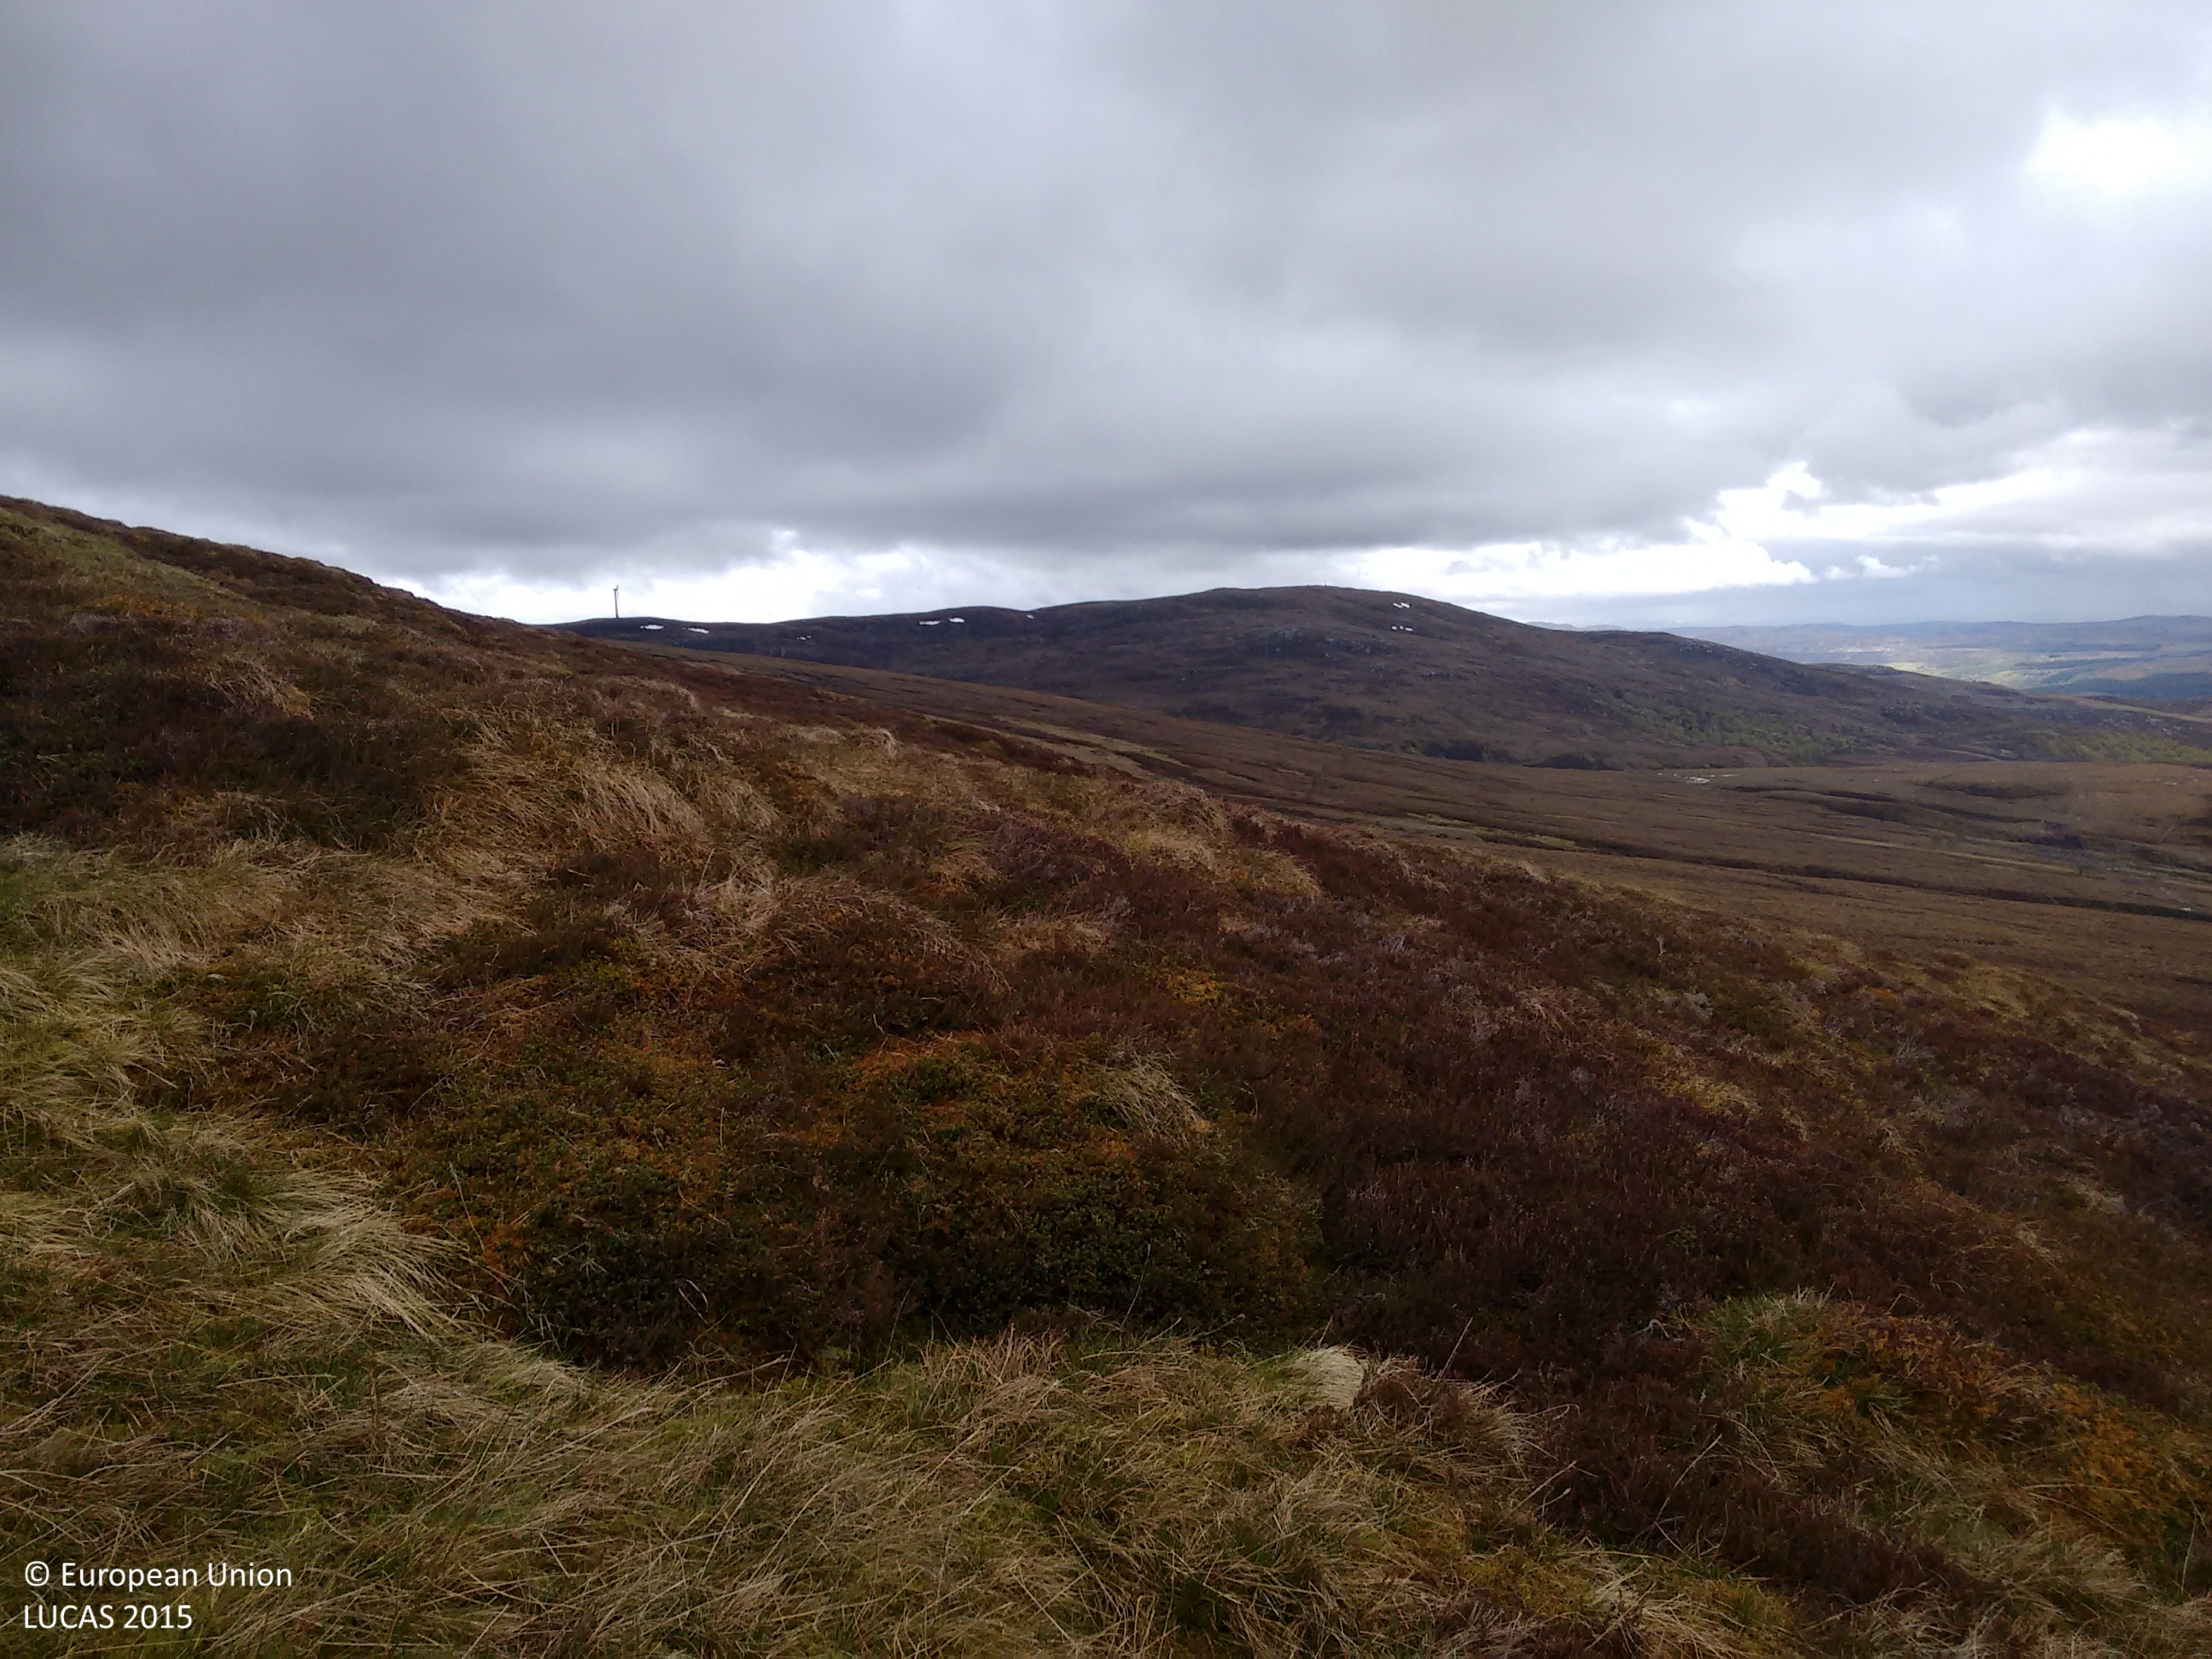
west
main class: Shrubland
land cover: Shrubland without tree cover
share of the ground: > 75 %
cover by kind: herbaceous plants 60 %, shrubs 40 %
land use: Agriculture (excluding fallow land and kitchen gardens)
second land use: Other primary production
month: June
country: GB
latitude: 57.2487
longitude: -4.2912
